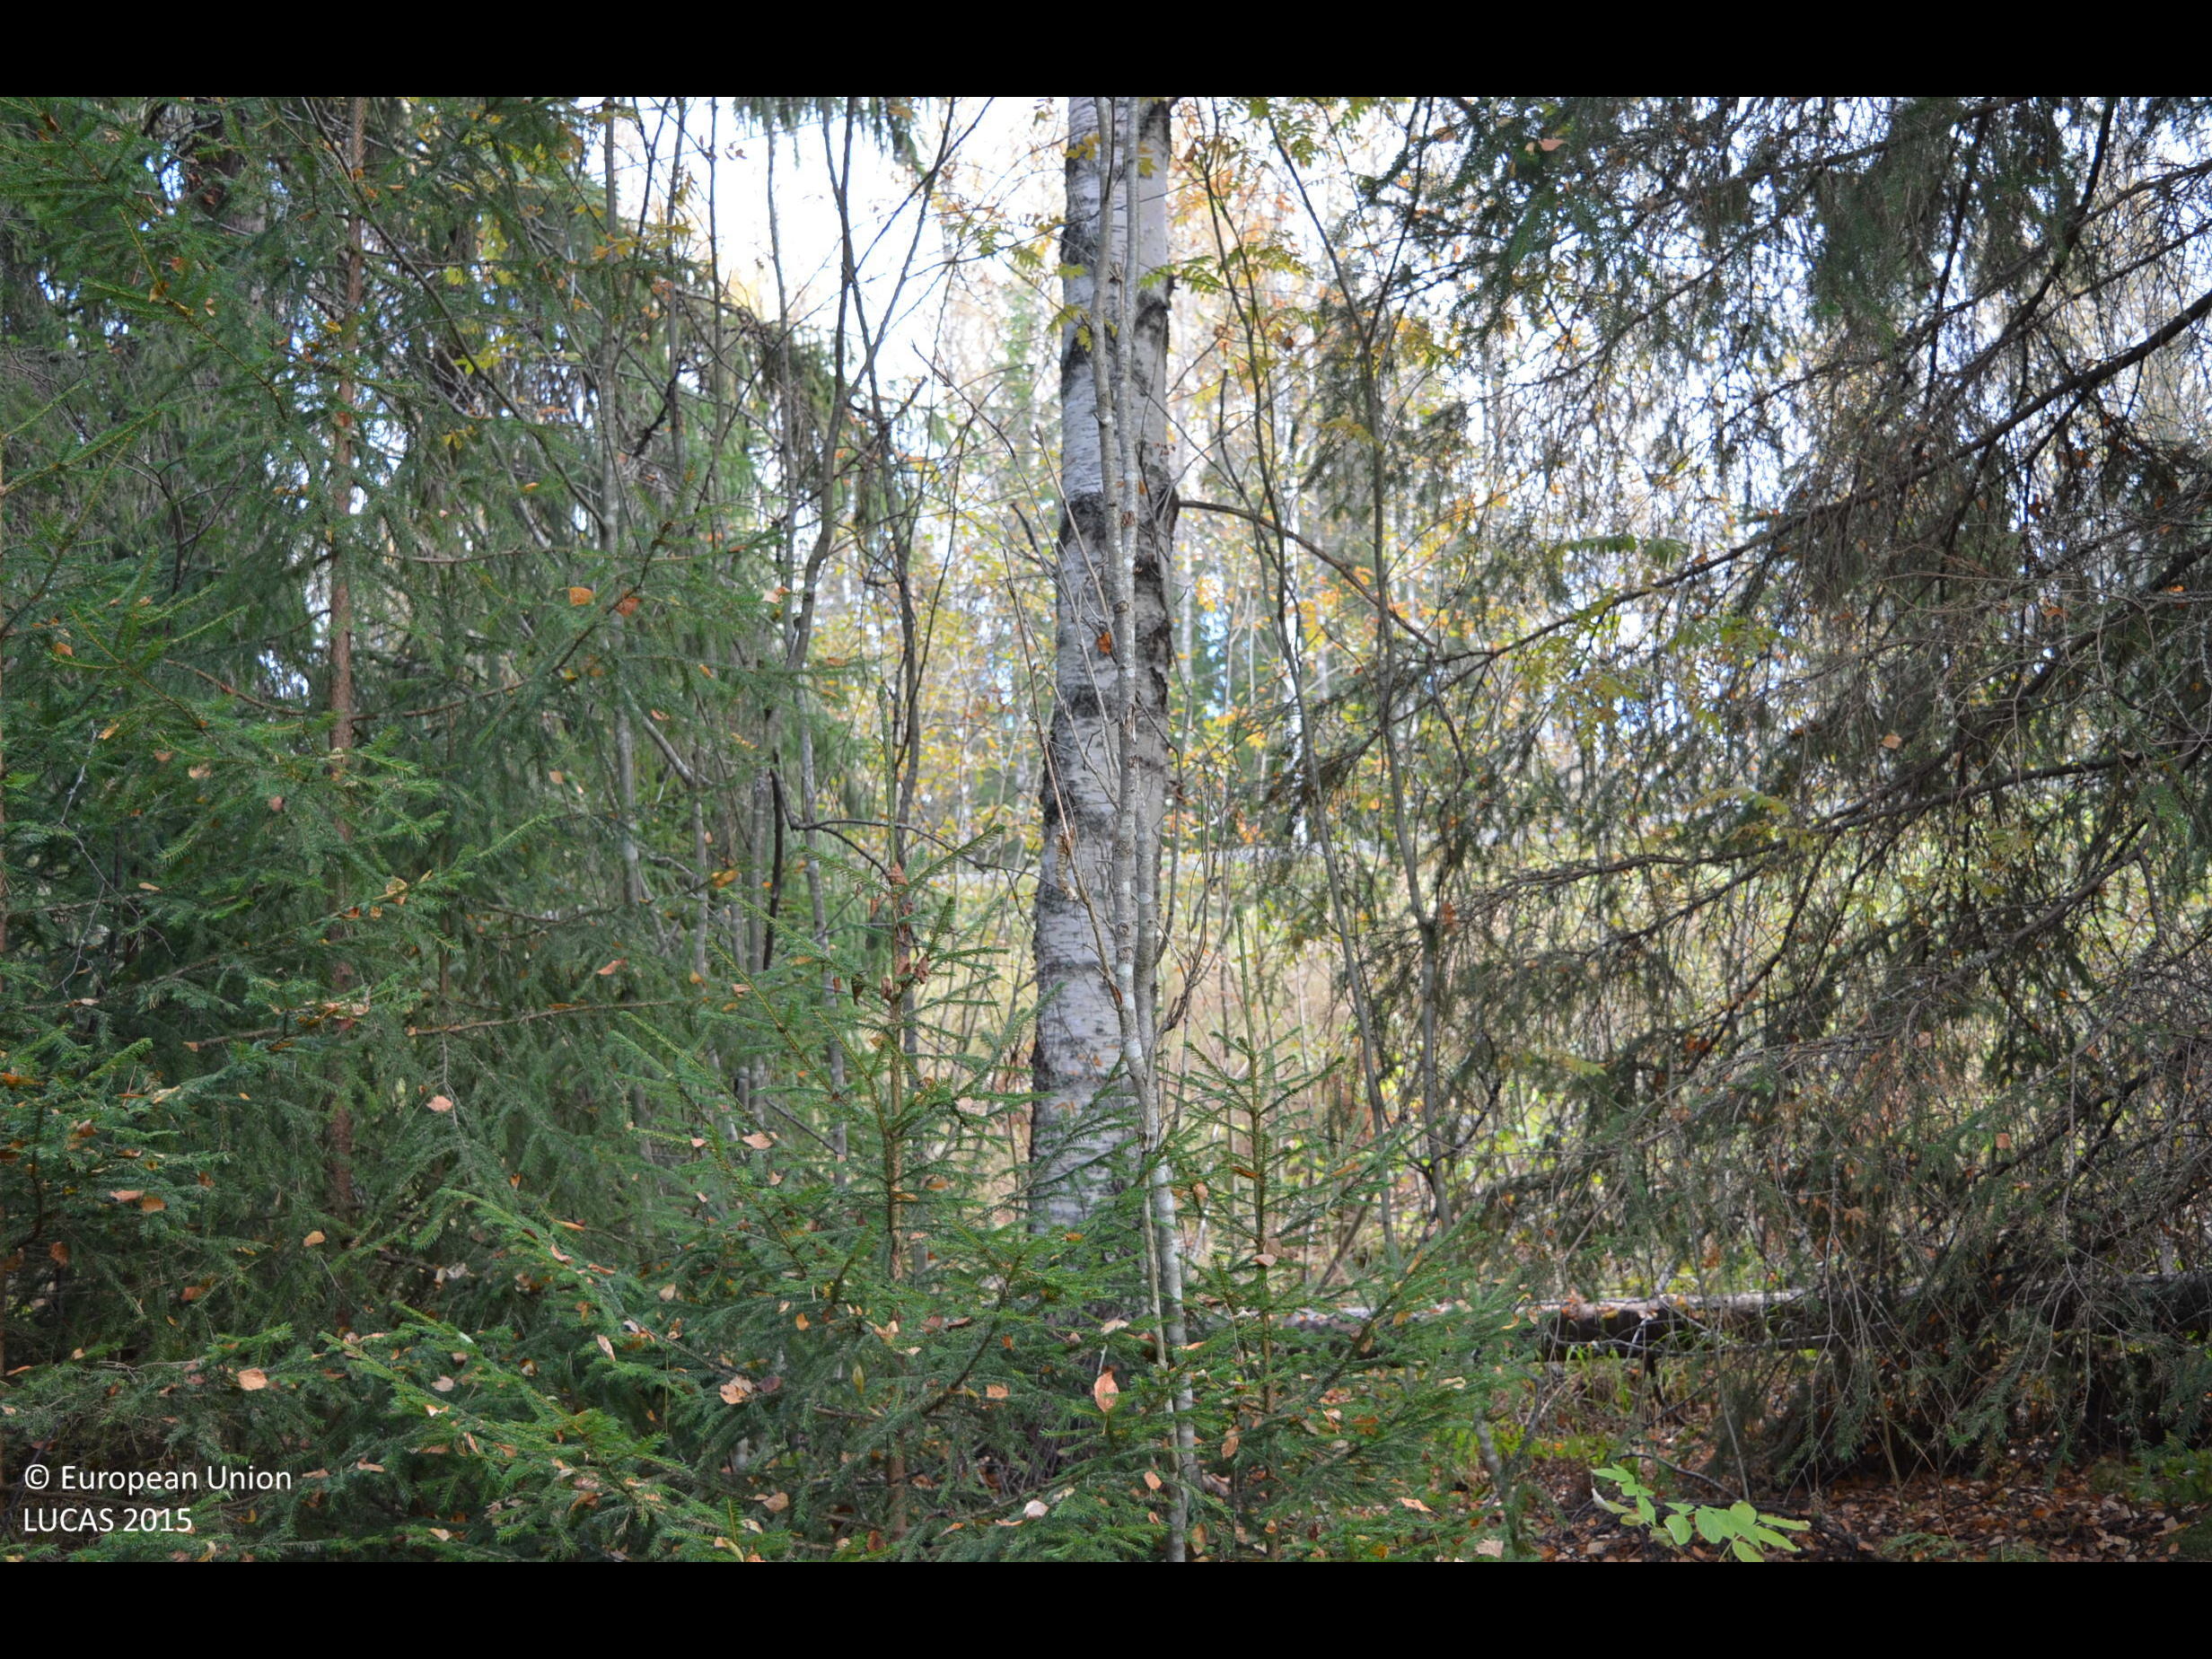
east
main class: Woodland
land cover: Spruce dominated mixed woodland
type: boreal forest
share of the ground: 50 - 75 %
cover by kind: coniferous forest trees 35 %, broadleaved forest trees 35 %, herbaceous plants 25 %, shrubs 5 %
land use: Forestry
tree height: > 5 m
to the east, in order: Spruce dominated mixed woodland; Electric lines; Grassland without tree/shrub cover; Paved roads, cycling and walking lanes; Grassland without tree/shrub cover; Spruce dominated mixed woodland; Ditches and canals; Spruce dominated coniferous woodland; Ditches and canals; Spruce dominated coniferous woodland; Ditches and canals; Spruce dominated coniferous woodland; Ditches and canals; Spruce dominated coniferous woodland; Ditches and canals; Spruce dominated coniferous woodland
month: October
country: FI
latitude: 61.6914
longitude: 23.8647
